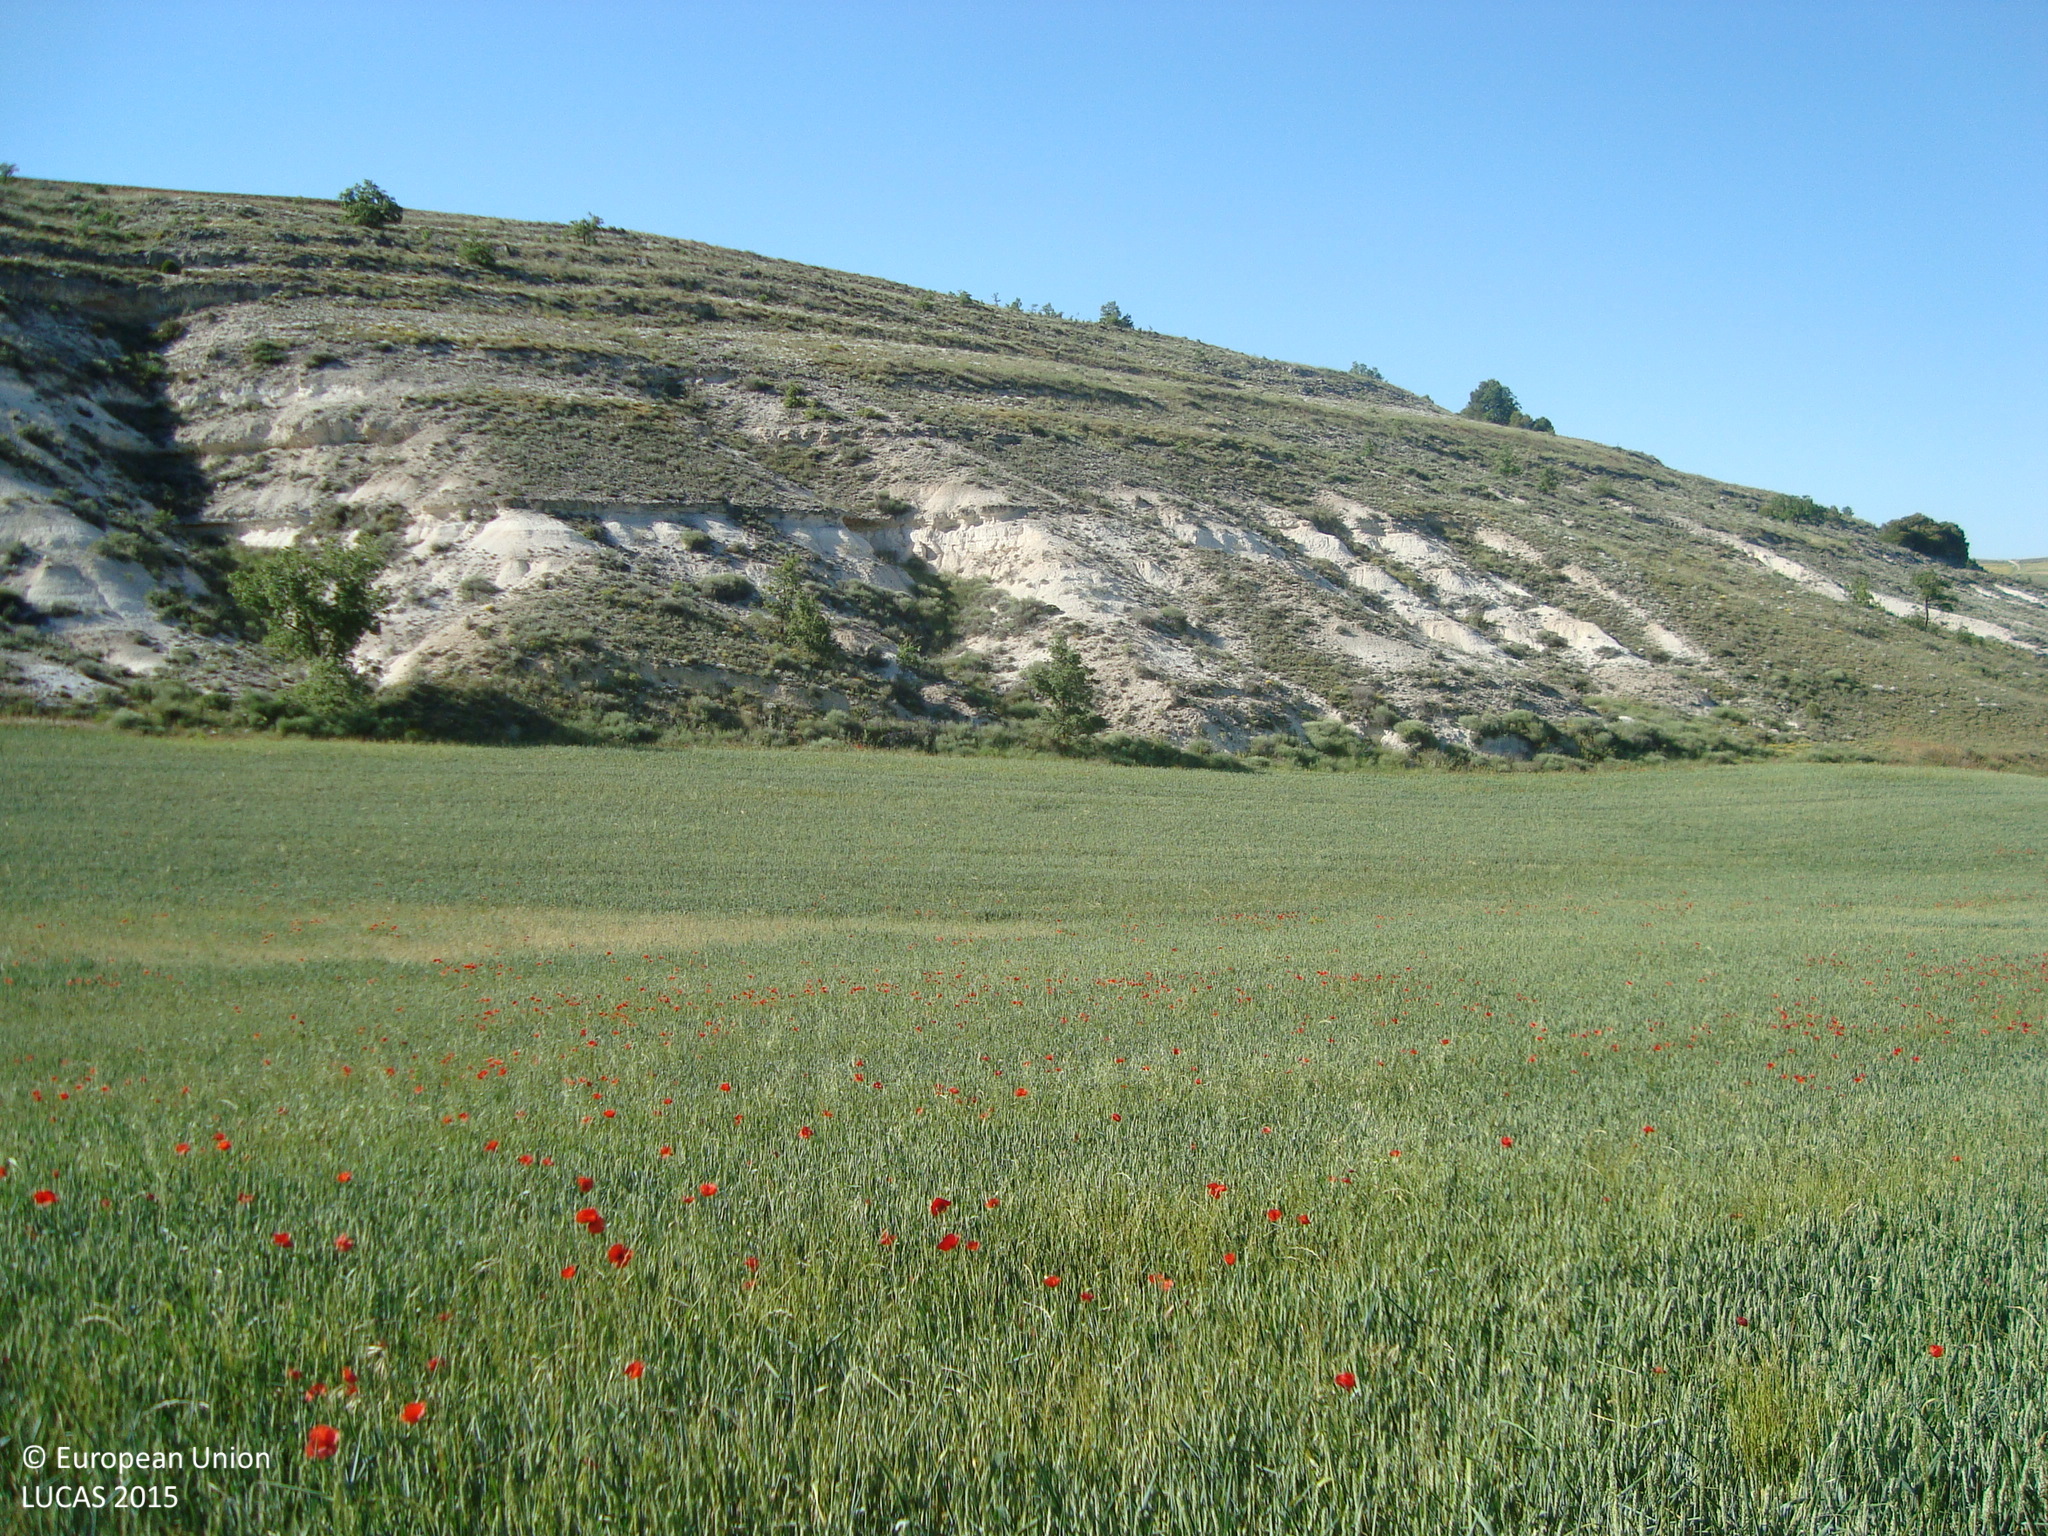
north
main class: Cropland
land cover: Common wheat
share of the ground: > 75 %
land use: Agriculture (excluding fallow land and kitchen gardens)
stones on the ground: < 10 %
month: May
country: ES
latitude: 41.5206
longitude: -4.0651
